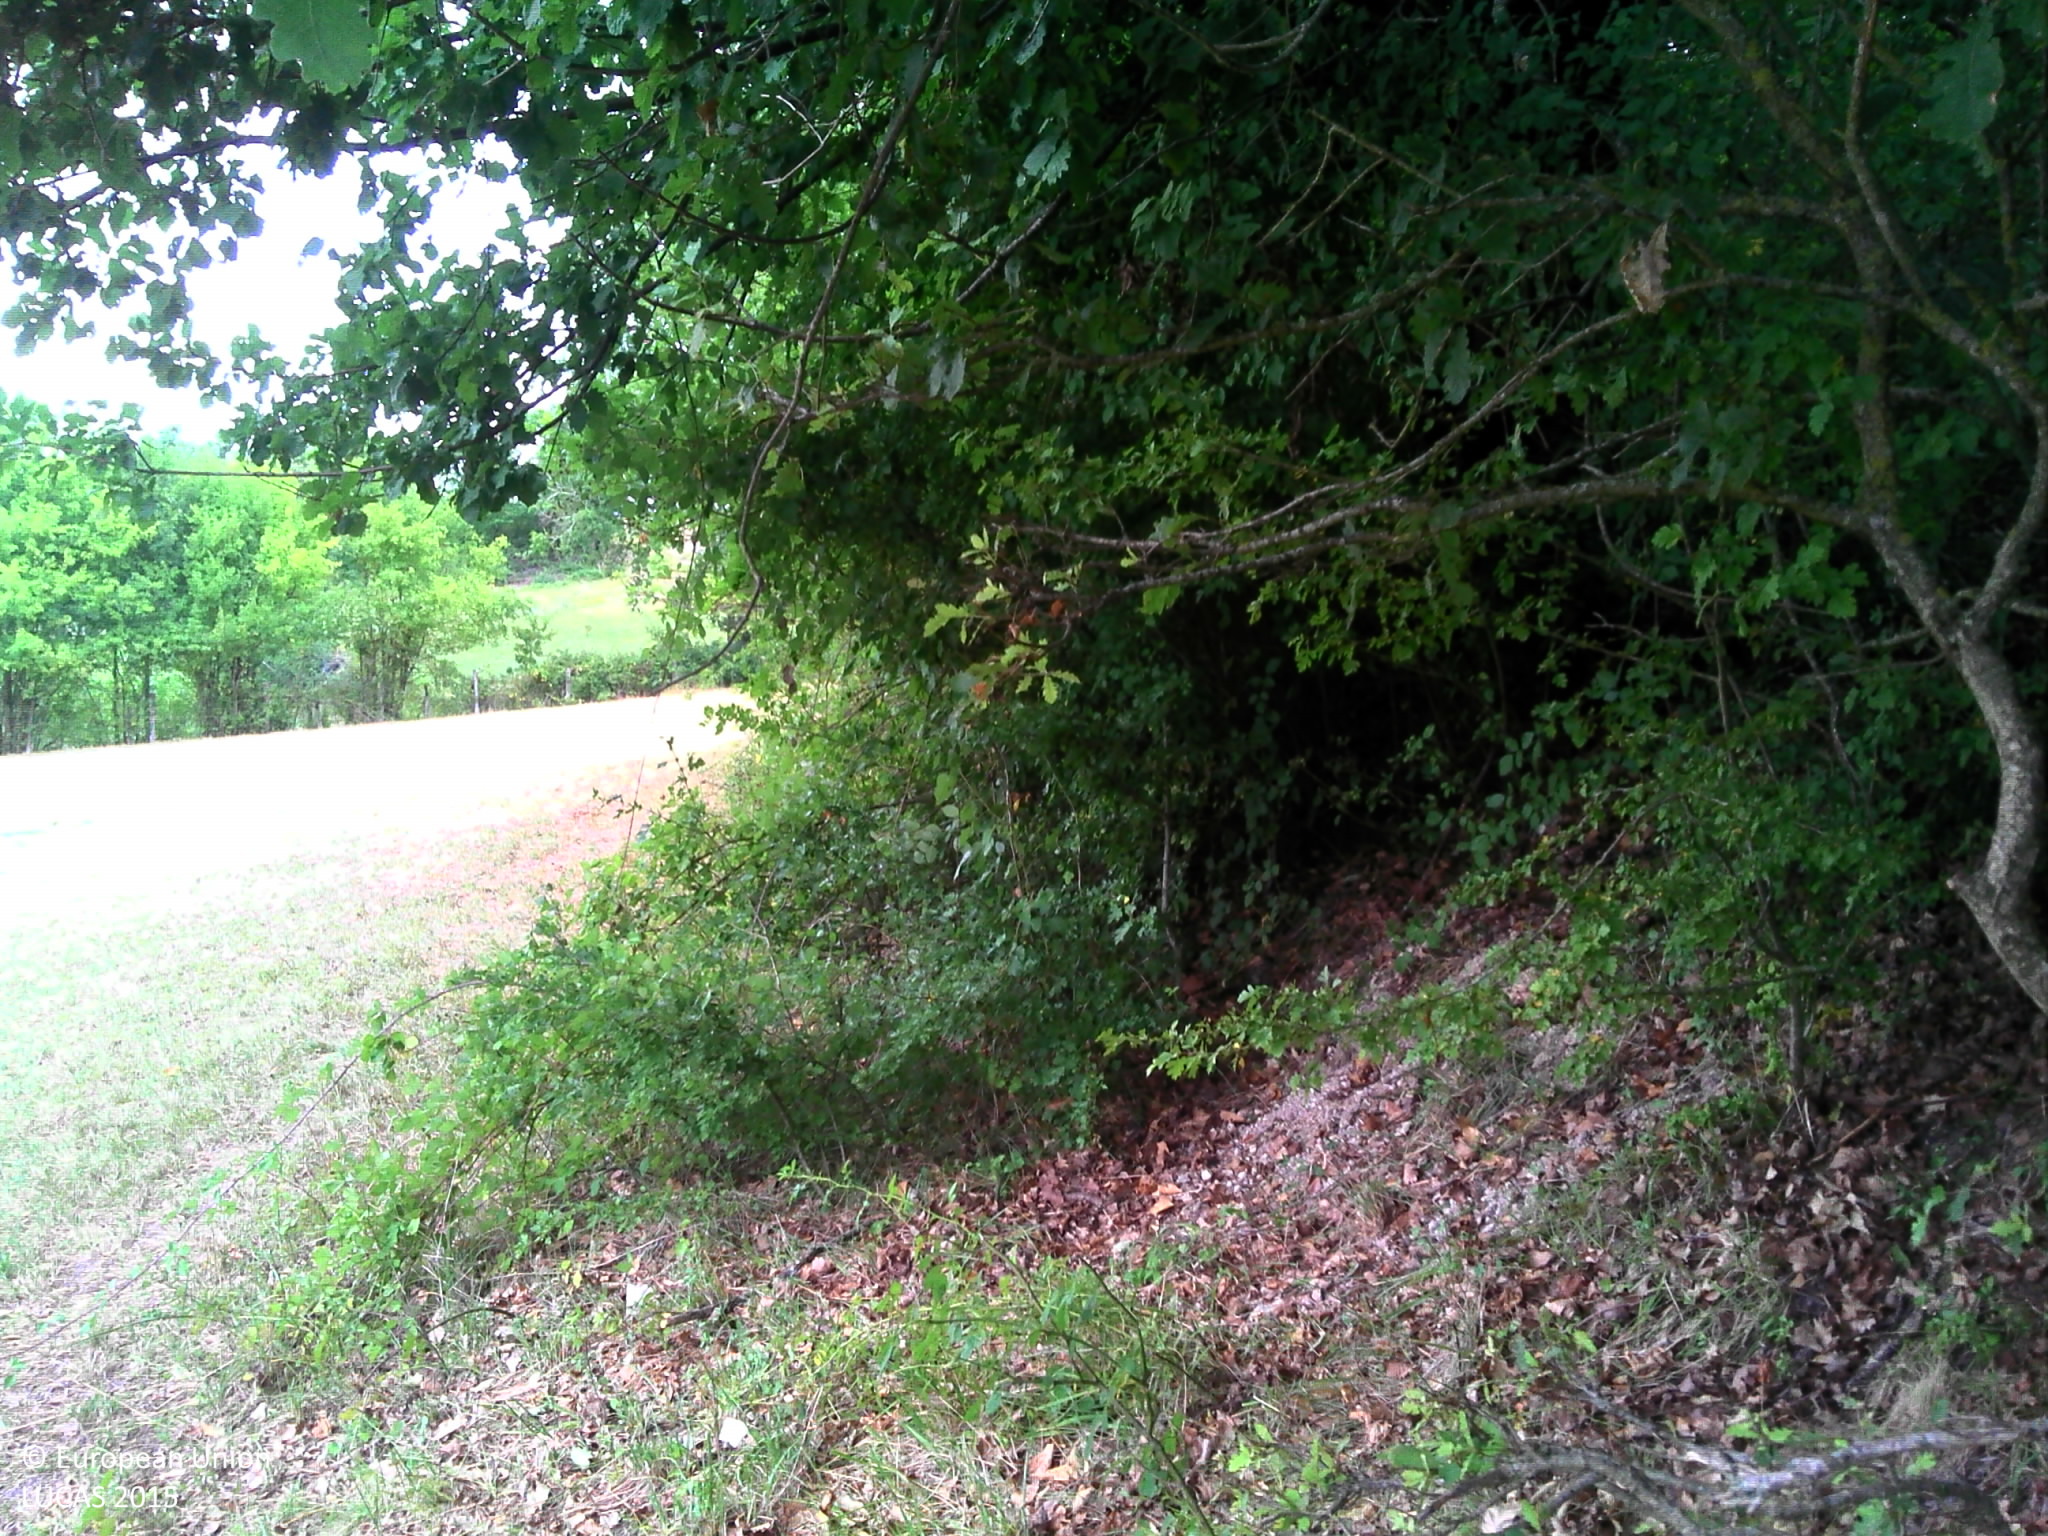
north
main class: Woodland
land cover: Broadleaved woodland
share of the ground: > 75 %
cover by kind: broadleaved forest trees 80 %, shrubs 20 %
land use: Agriculture (excluding fallow land and kitchen gardens)
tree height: > 5 m
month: July
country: FR
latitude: 44.6688
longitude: 0.8235
